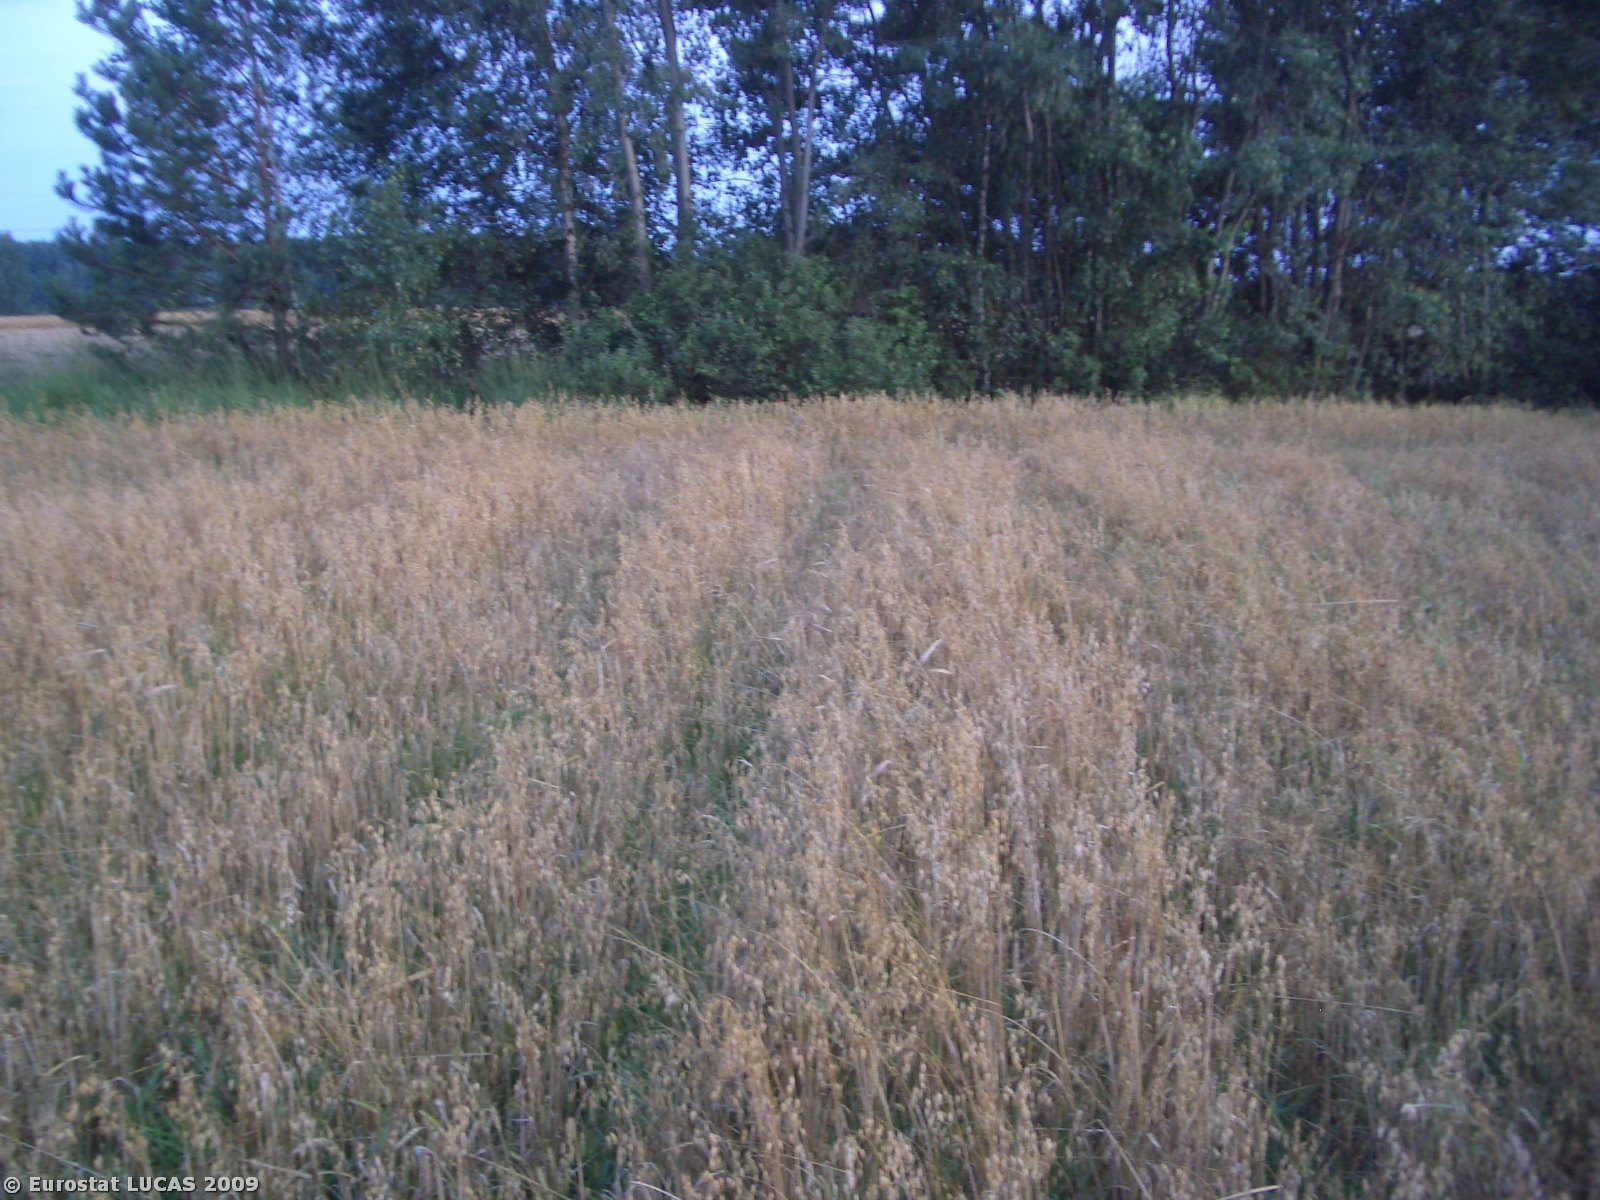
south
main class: Cropland
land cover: Oats
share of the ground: 50 - 75 %
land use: Agriculture (excluding fallow land and kitchen gardens)
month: August
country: PL
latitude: 51.8352
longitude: 23.2128
